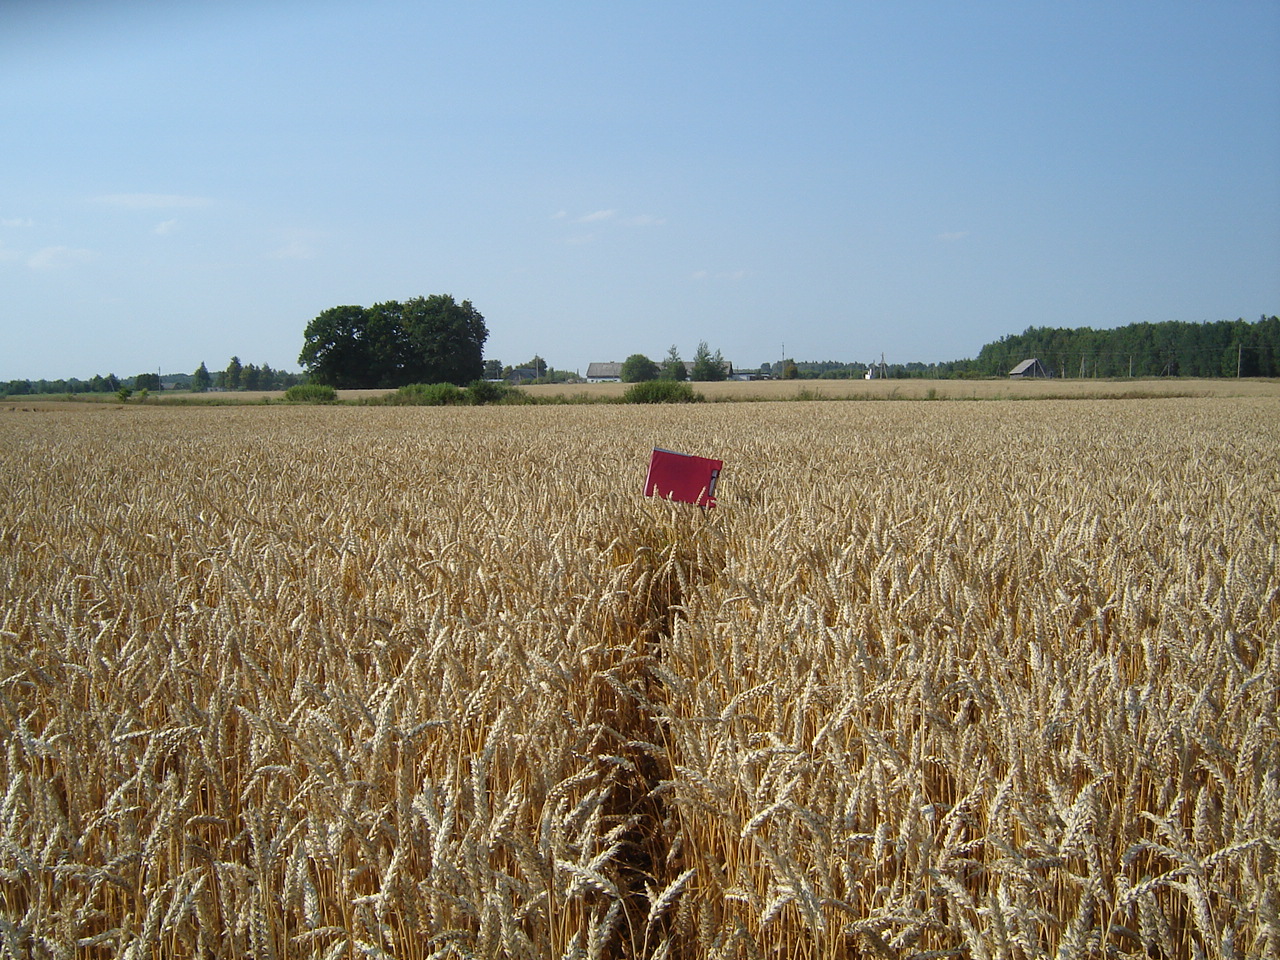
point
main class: Cropland
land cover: Common wheat
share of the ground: > 75 %
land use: Agriculture (excluding fallow land and kitchen gardens)
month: August
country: LT
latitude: 55.0852
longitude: 24.9479
